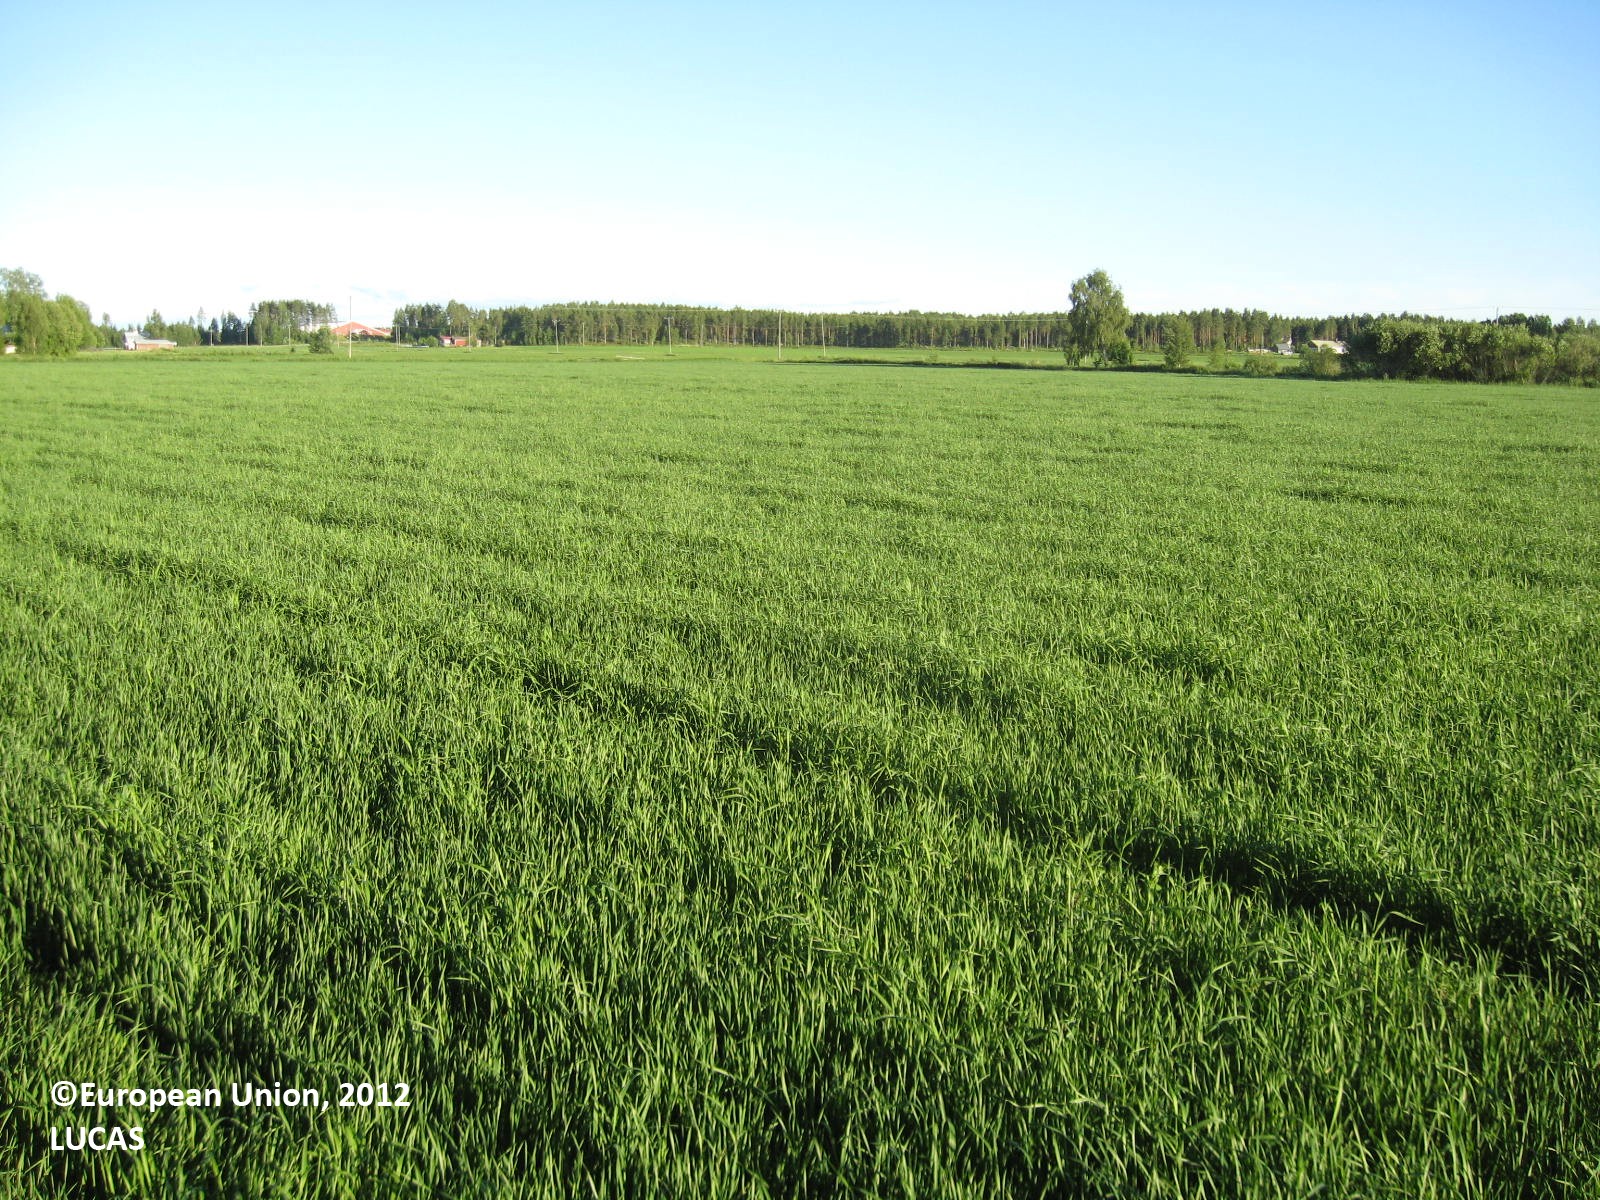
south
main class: Cropland
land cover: Oats
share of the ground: > 75 %
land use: Agriculture (excluding fallow land and kitchen gardens)
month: July
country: FI
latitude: 62.6736
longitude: 22.7300
